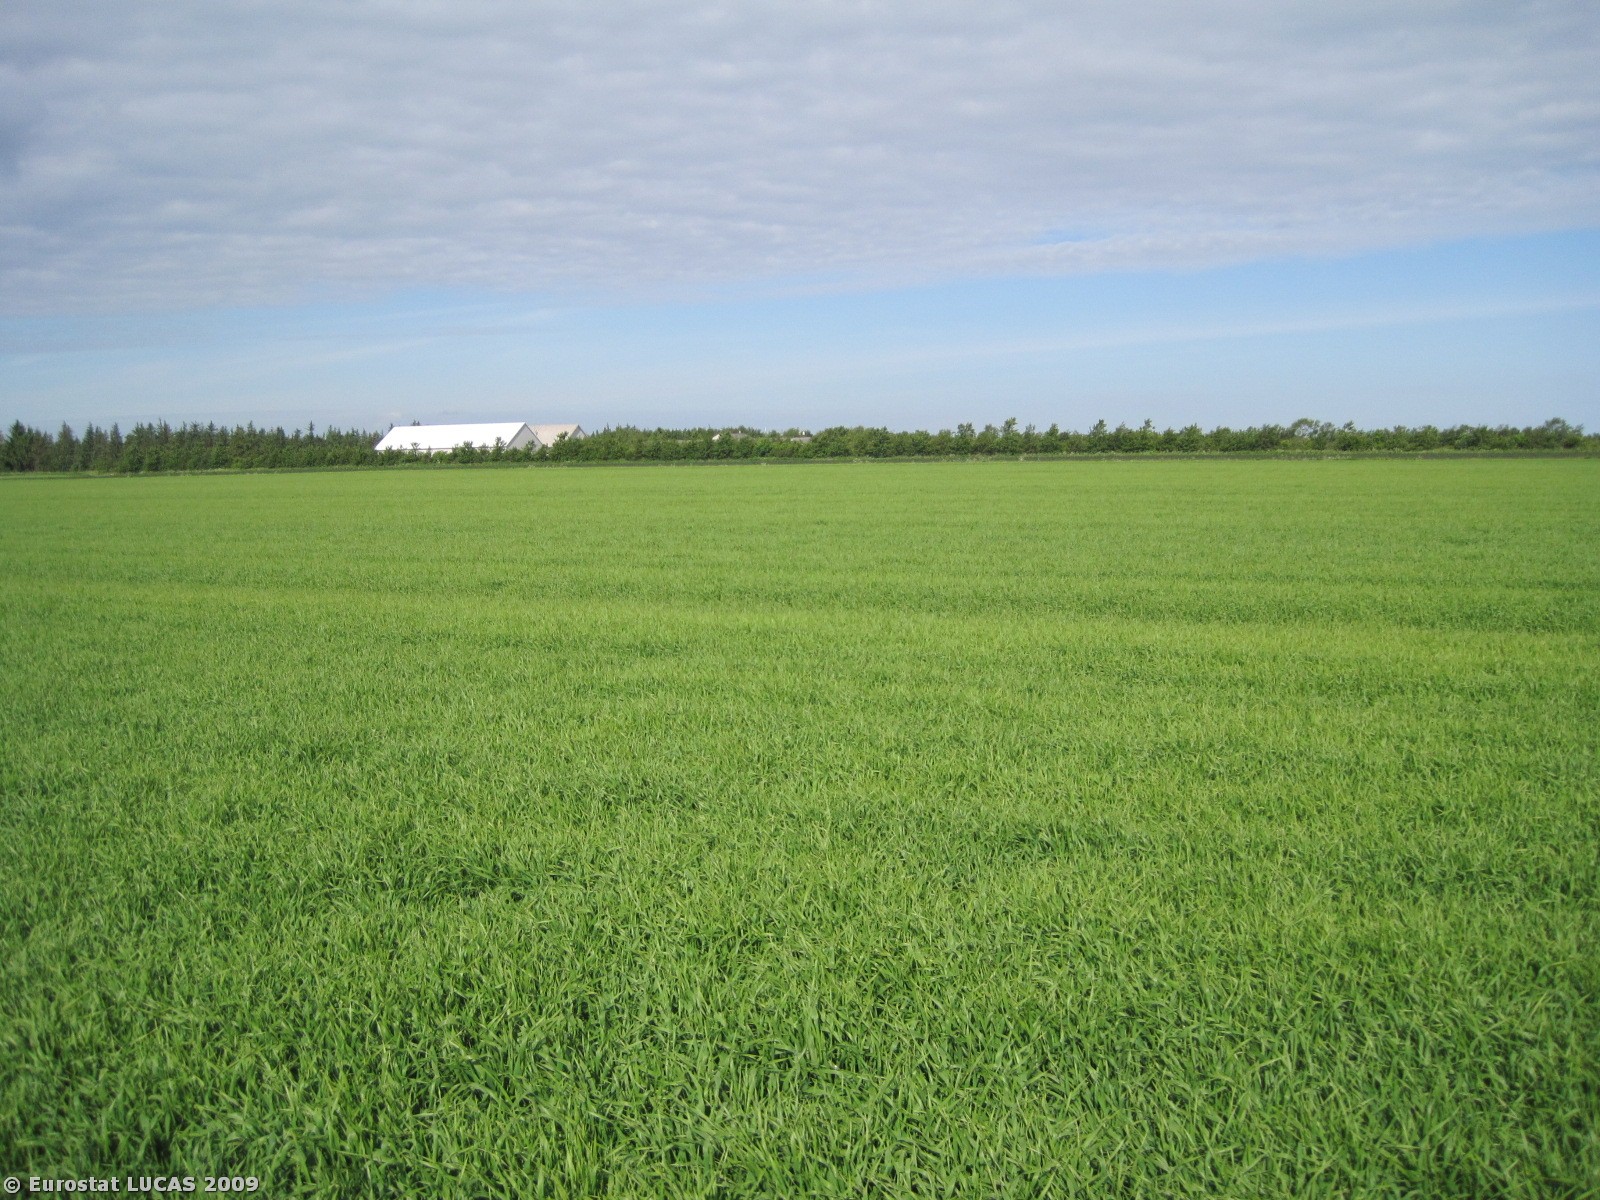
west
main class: Cropland
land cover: Barley
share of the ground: > 75 %
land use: Agriculture (excluding fallow land and kitchen gardens)
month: June
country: DK
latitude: 57.2123
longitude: 9.8182
